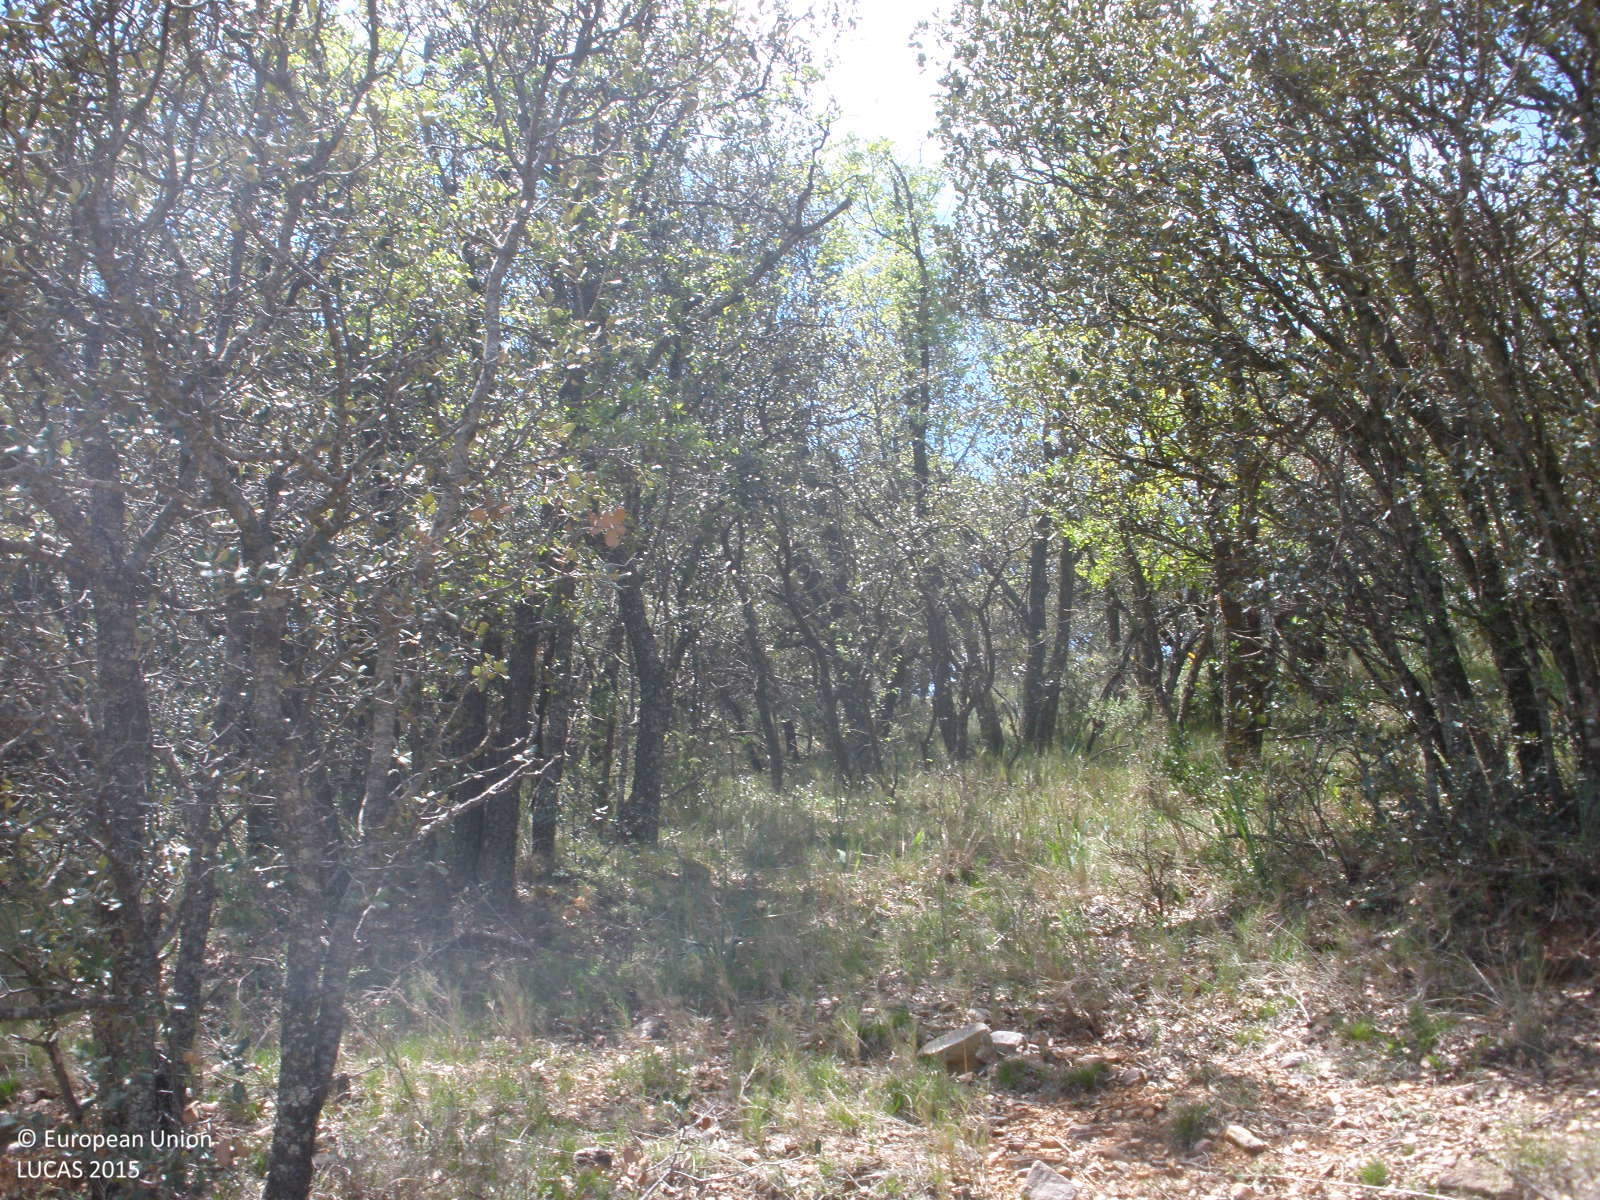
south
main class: Woodland
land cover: Broadleaved woodland
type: broadleaved evergreen forest
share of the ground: > 75 %
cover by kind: broadleaved forest trees 70 %, shrubs 20 %, consolidated bare surface 10 %
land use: Semi-natural and natural areas not in use
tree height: > 5 m
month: May
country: ES
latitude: 40.8777
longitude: -0.9201
